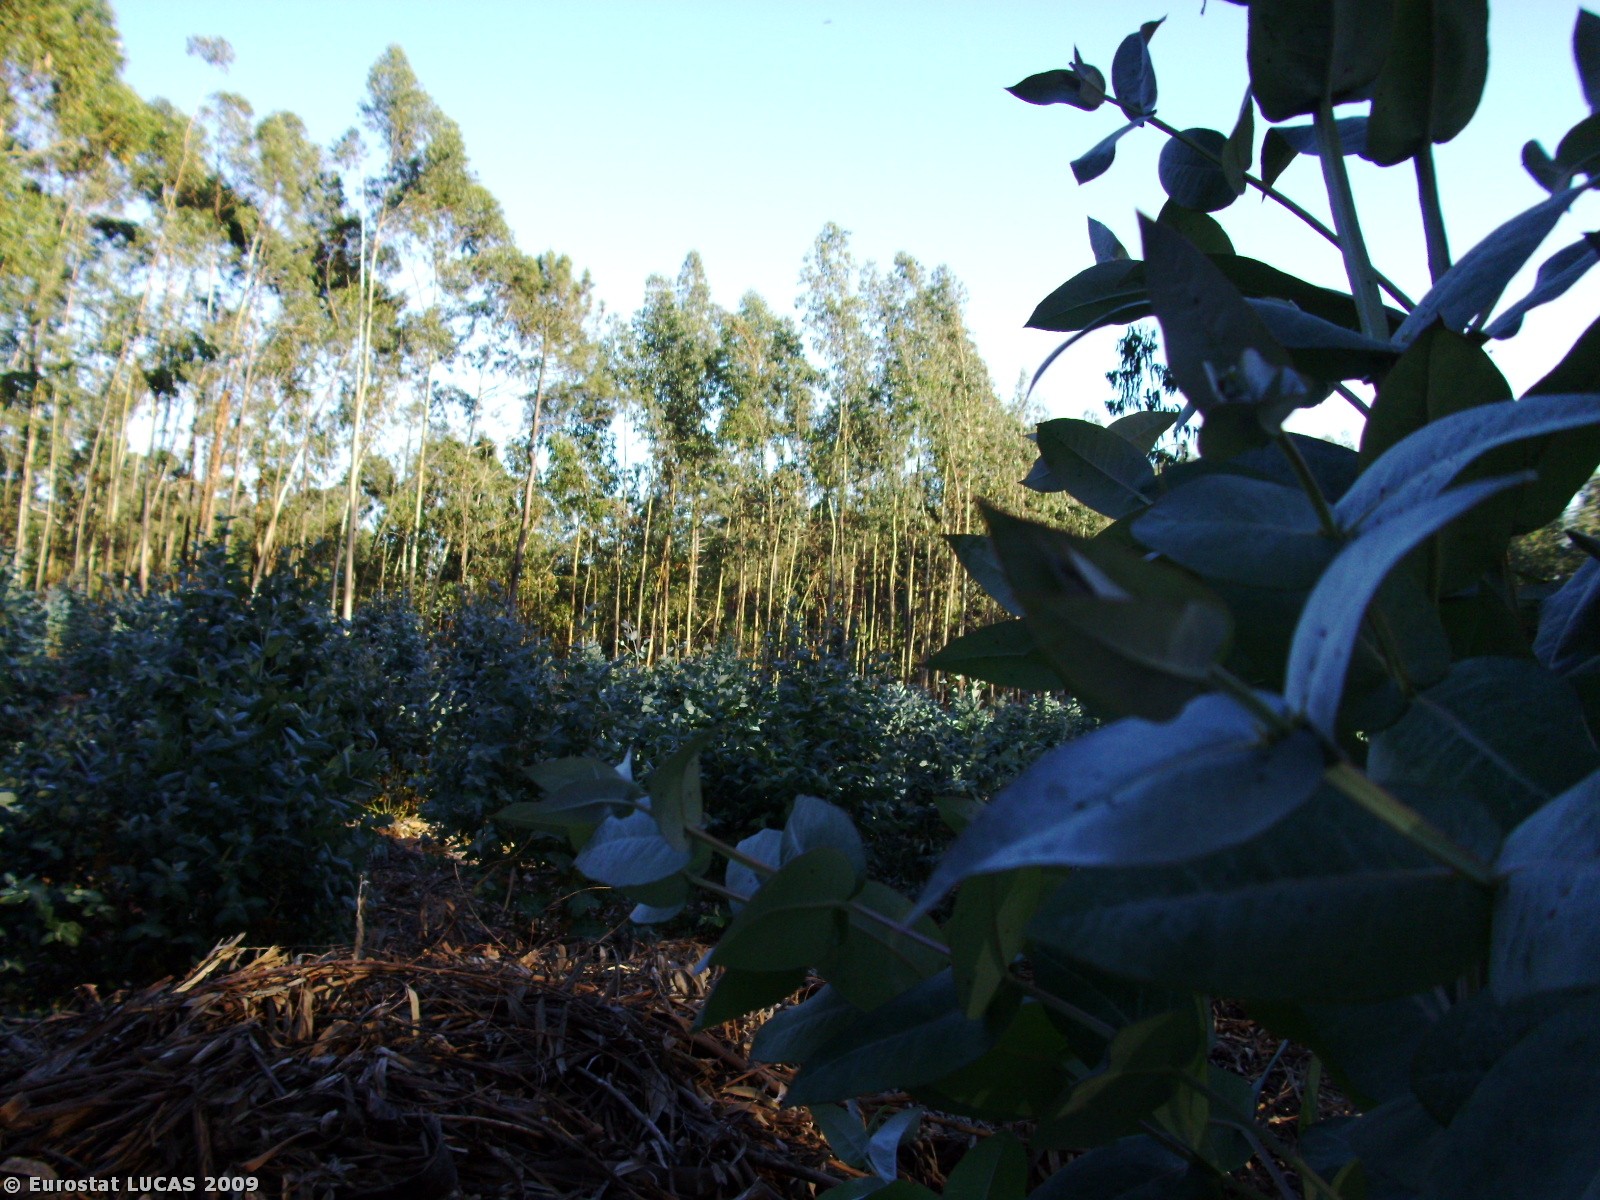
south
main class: Woodland
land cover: Broadleaved woodland
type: plantations and self-sown exotic forest
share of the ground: > 75 %
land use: Forestry
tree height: > 5 m
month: May
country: PT
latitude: 40.6183
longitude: -8.3999
